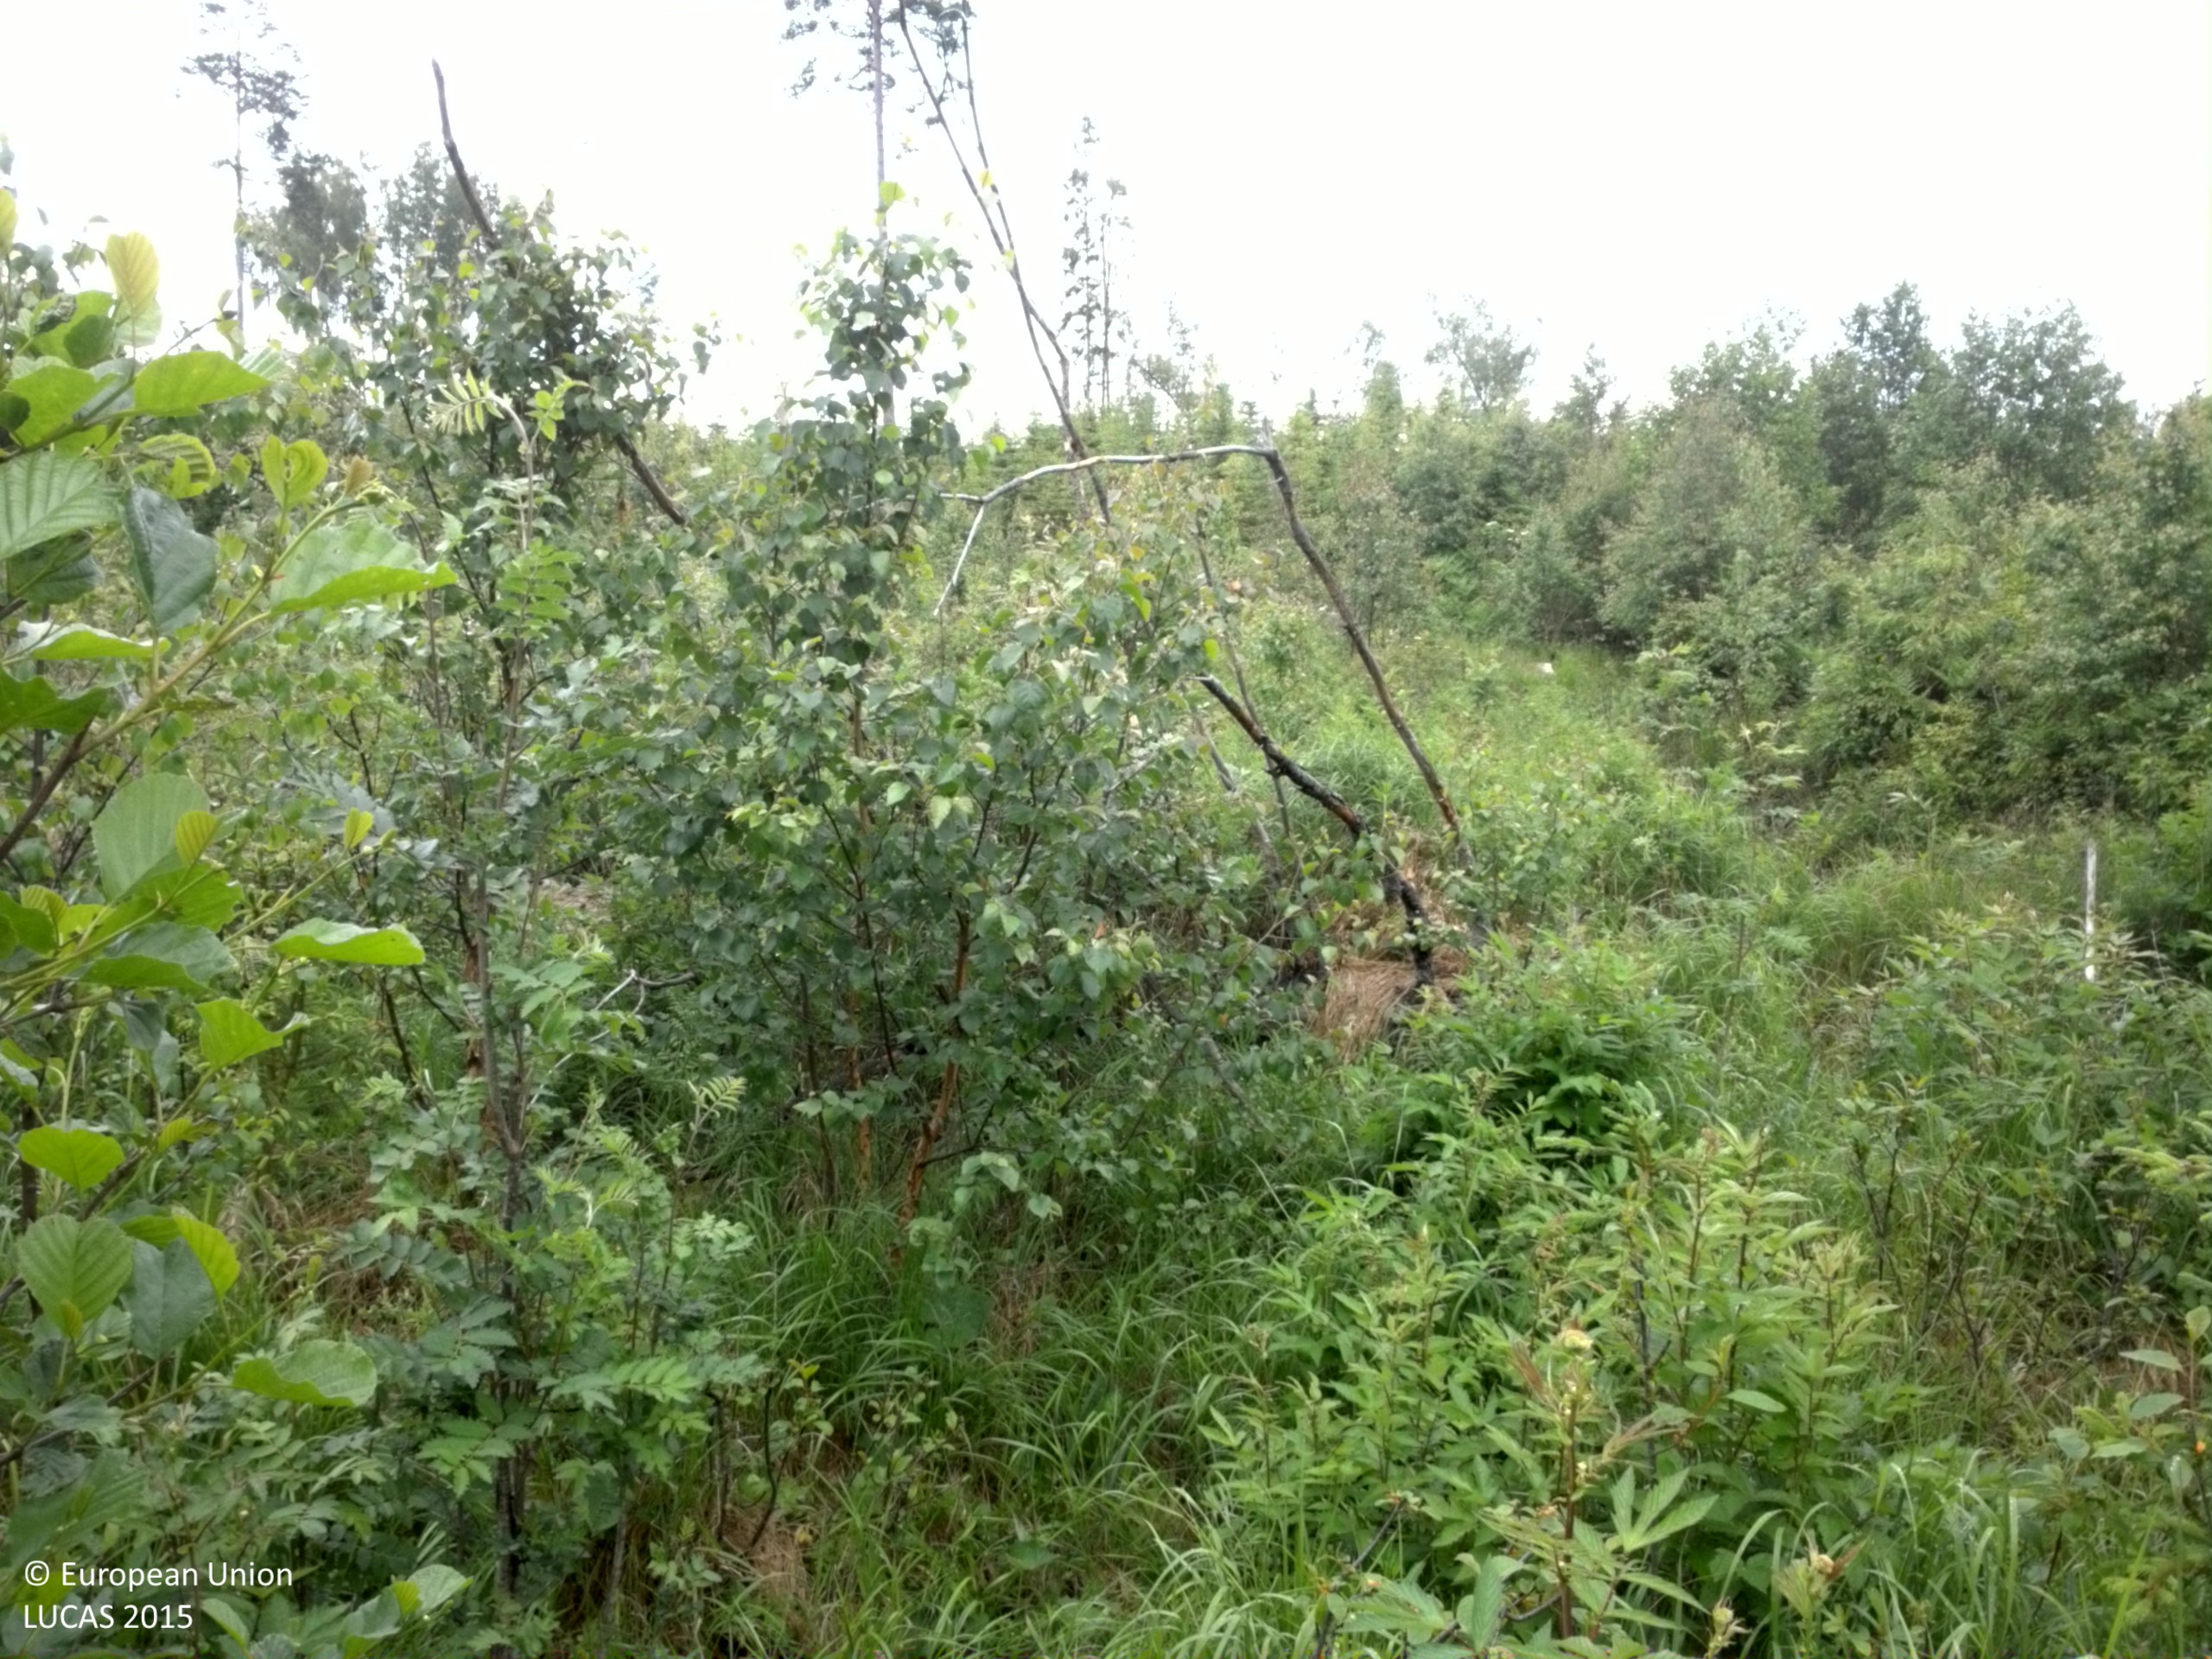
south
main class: Woodland
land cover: Broadleaved woodland
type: boreal forest
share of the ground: 25 - 50 %
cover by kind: broadleaved forest trees 45 %, herbaceous plants 30 %, shrubs 15 %, coniferous forest trees 5 %
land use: Forestry
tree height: < 5 m
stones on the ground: < 10 %
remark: Clear cut
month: June
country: SE
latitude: 60.3028
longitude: 17.5742
